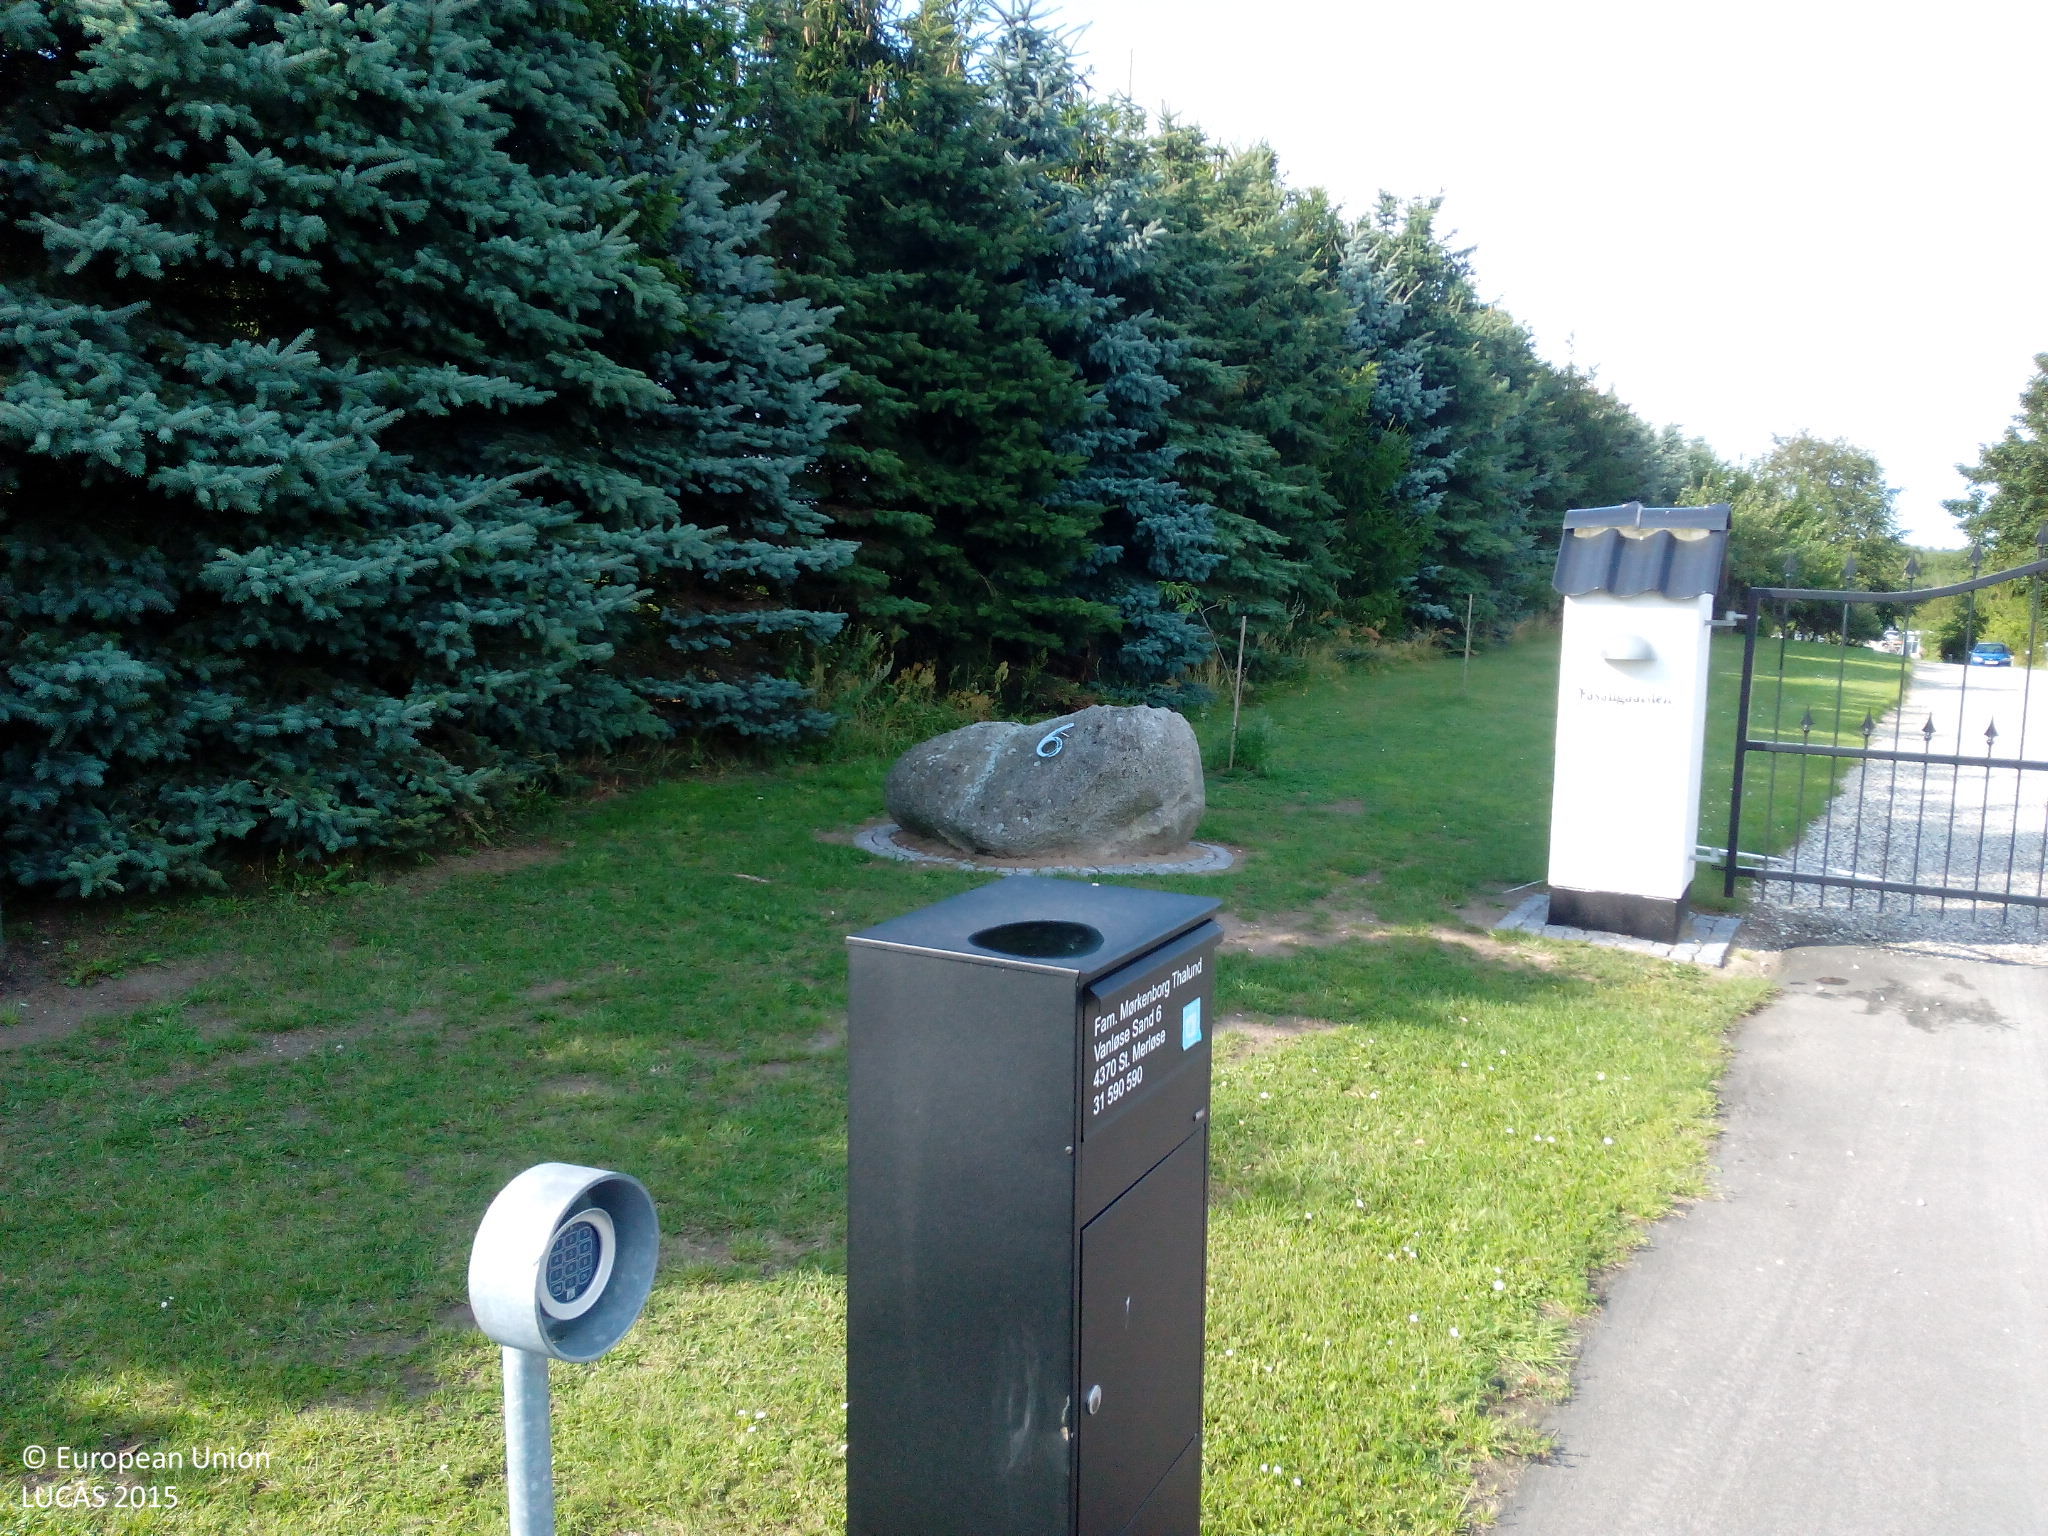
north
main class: Cropland
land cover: Barley
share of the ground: > 75 %
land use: Agriculture (excluding fallow land and kitchen gardens)
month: August
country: DK
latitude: 55.5657
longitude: 11.6635
